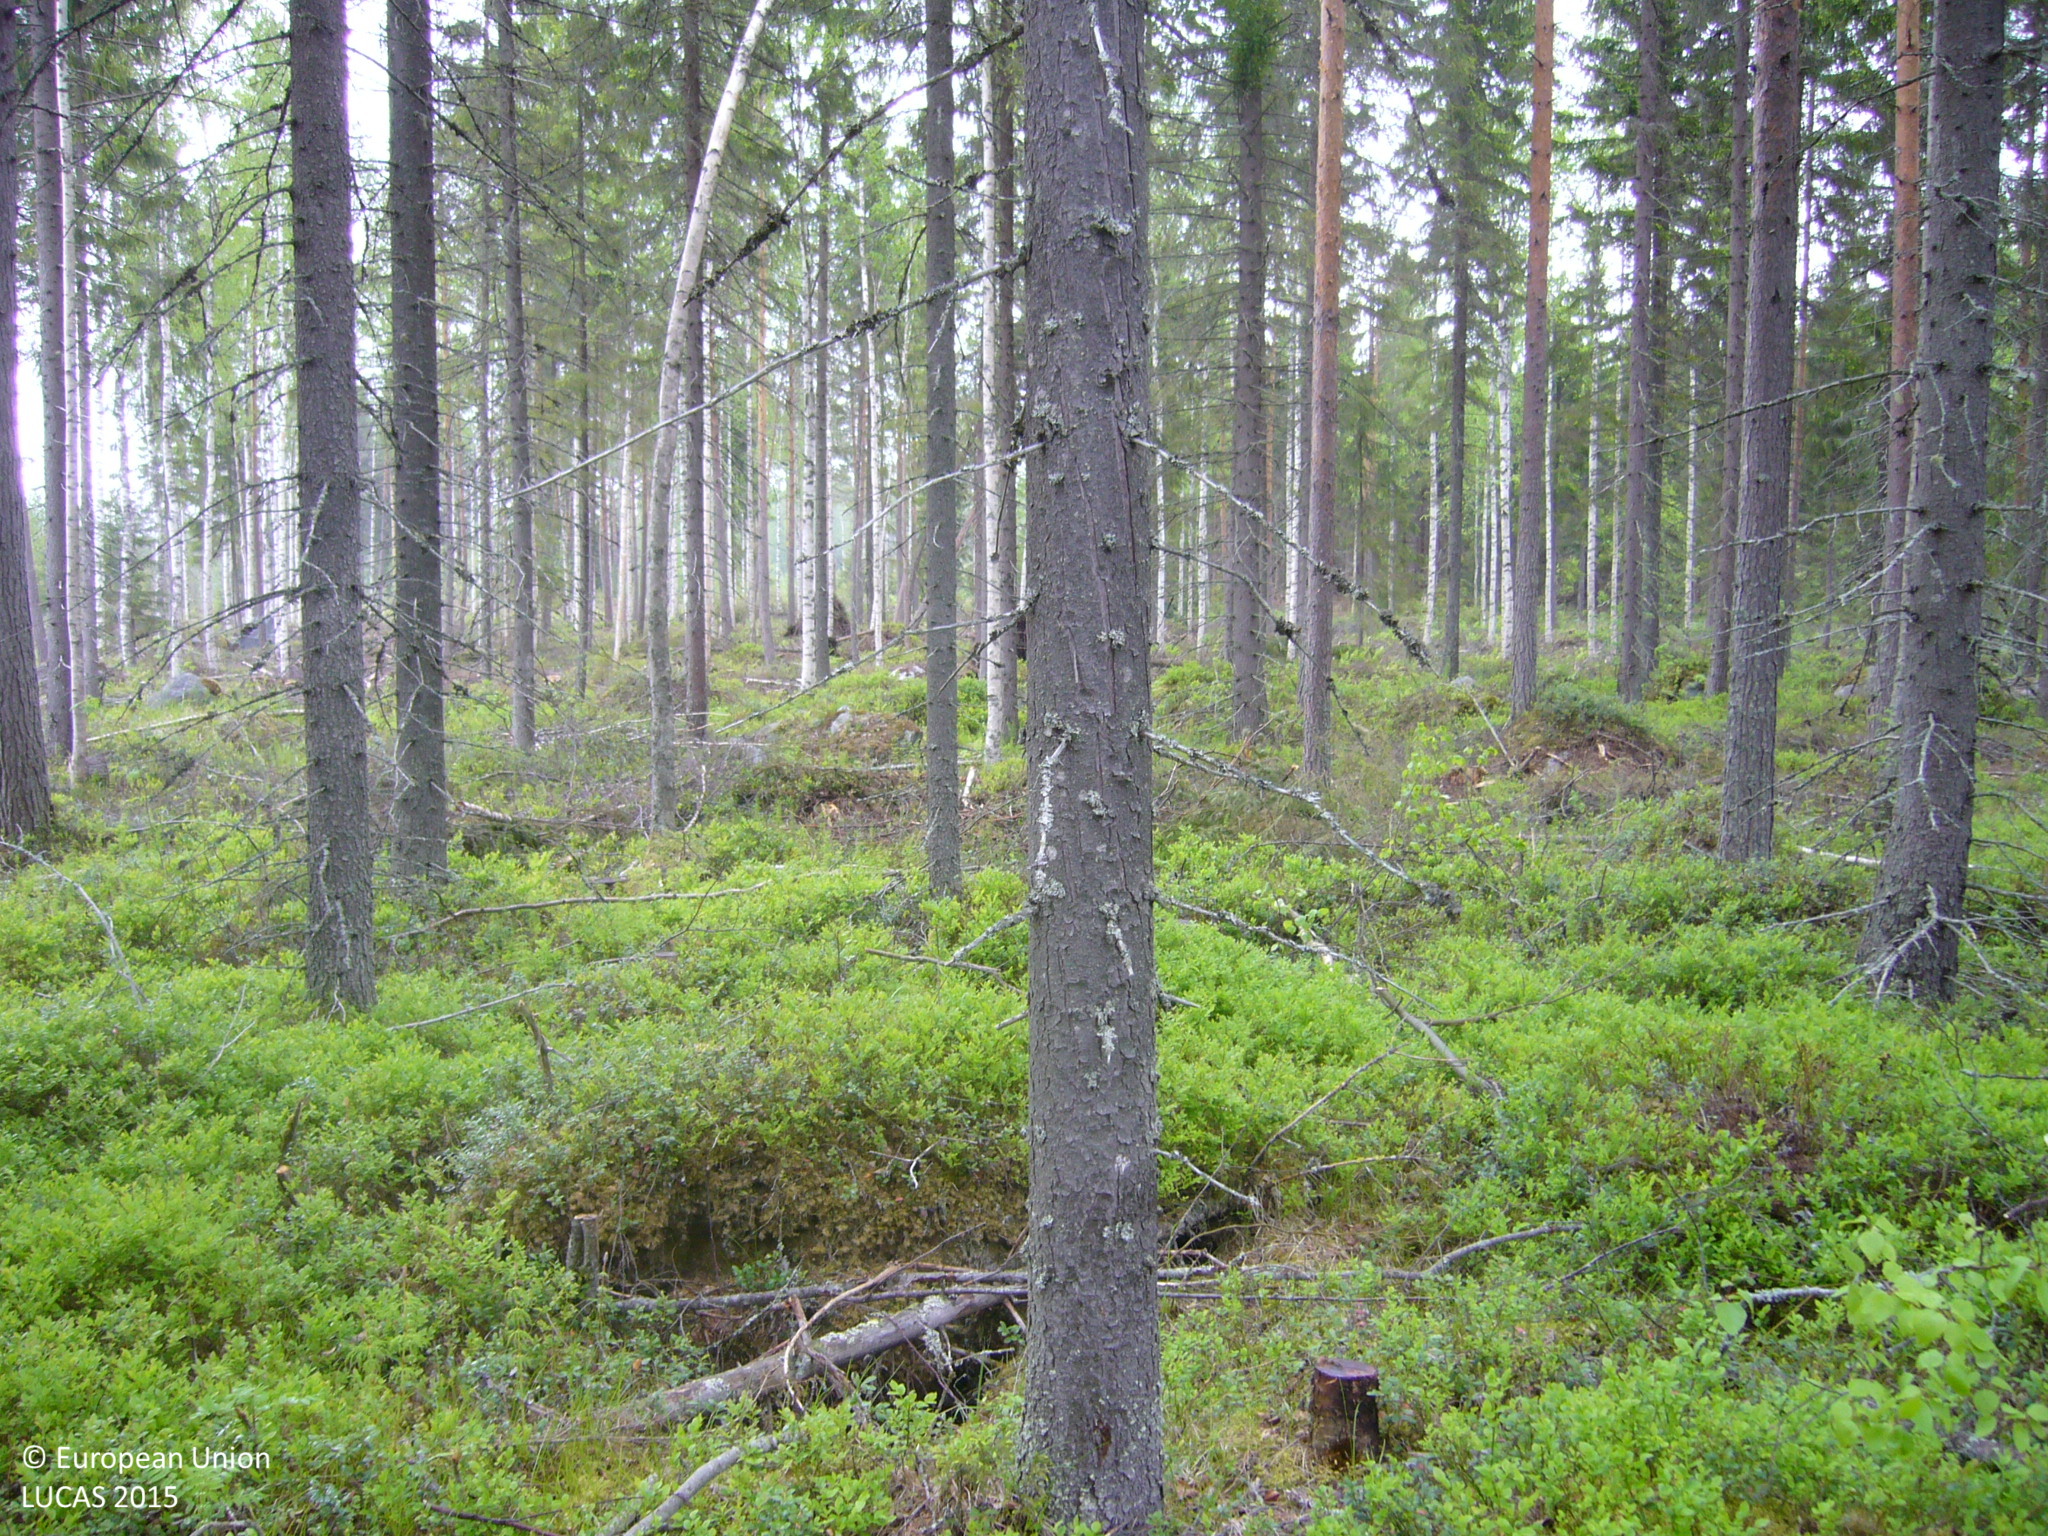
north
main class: Woodland
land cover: Spruce dominated coniferous woodland
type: boreal forest
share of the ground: 50 - 75 %
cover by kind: coniferous forest trees 60 %, shrubs 40 %
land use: Forestry
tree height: > 5 m
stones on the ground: 25 - 50 %
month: June
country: FI
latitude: 63.2326
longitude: 26.6321
